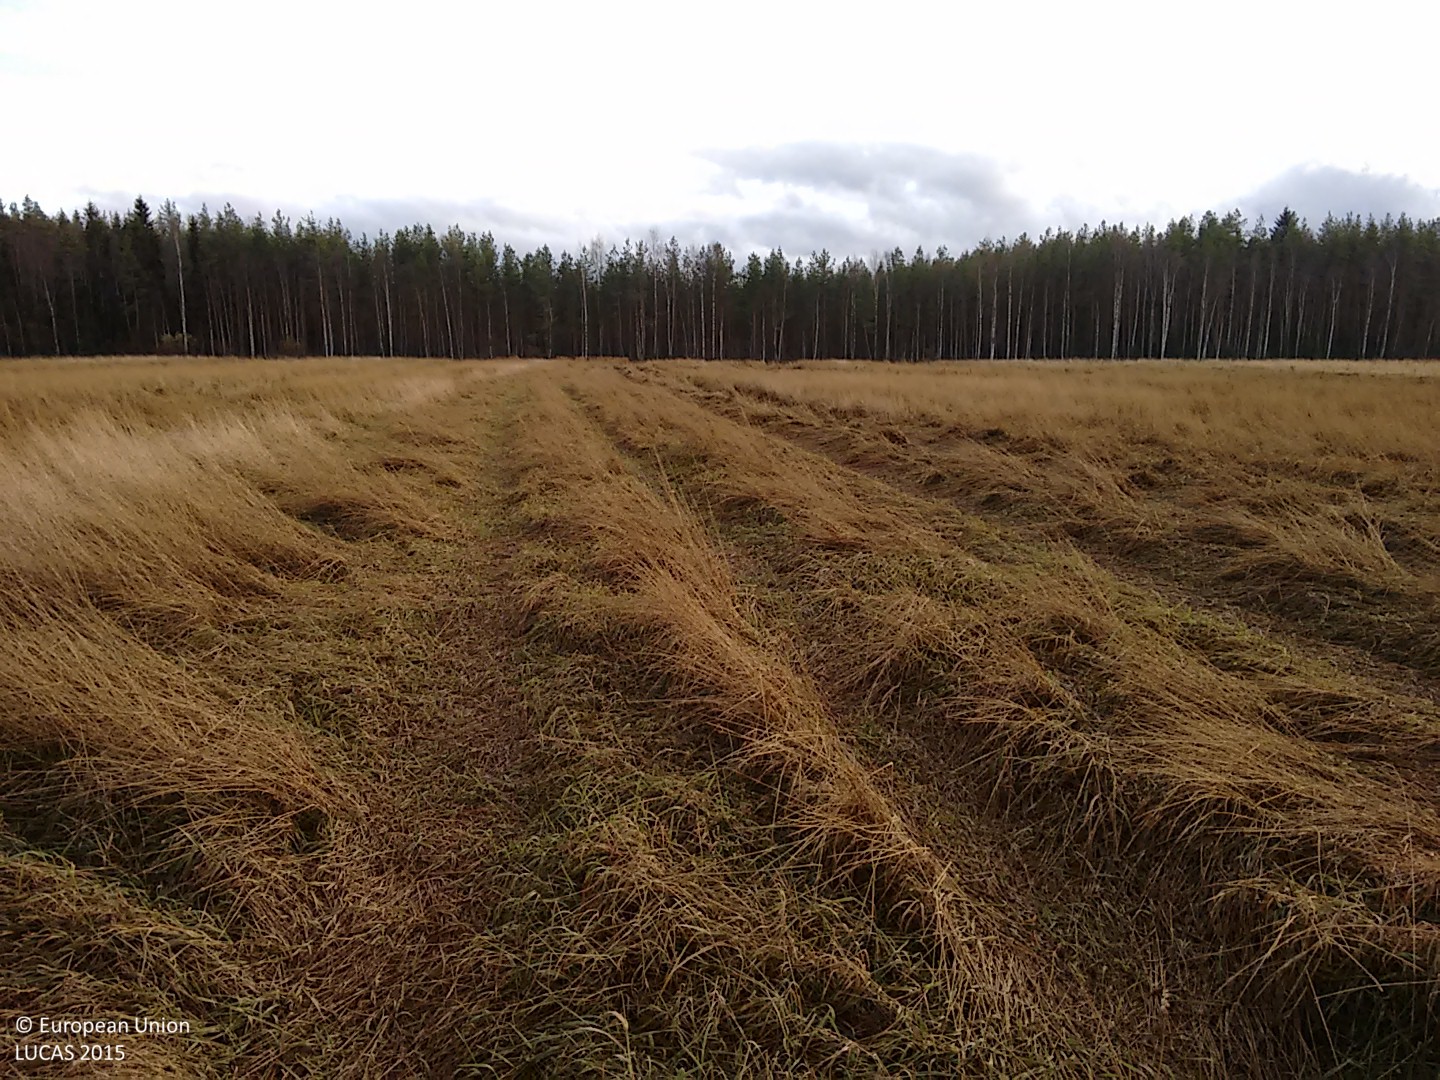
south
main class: Cropland
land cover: Temporary grasslands
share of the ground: > 75 %
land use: Agriculture (excluding fallow land and kitchen gardens)
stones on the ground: < 10 %
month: October
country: FI
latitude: 63.9478
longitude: 25.0869
